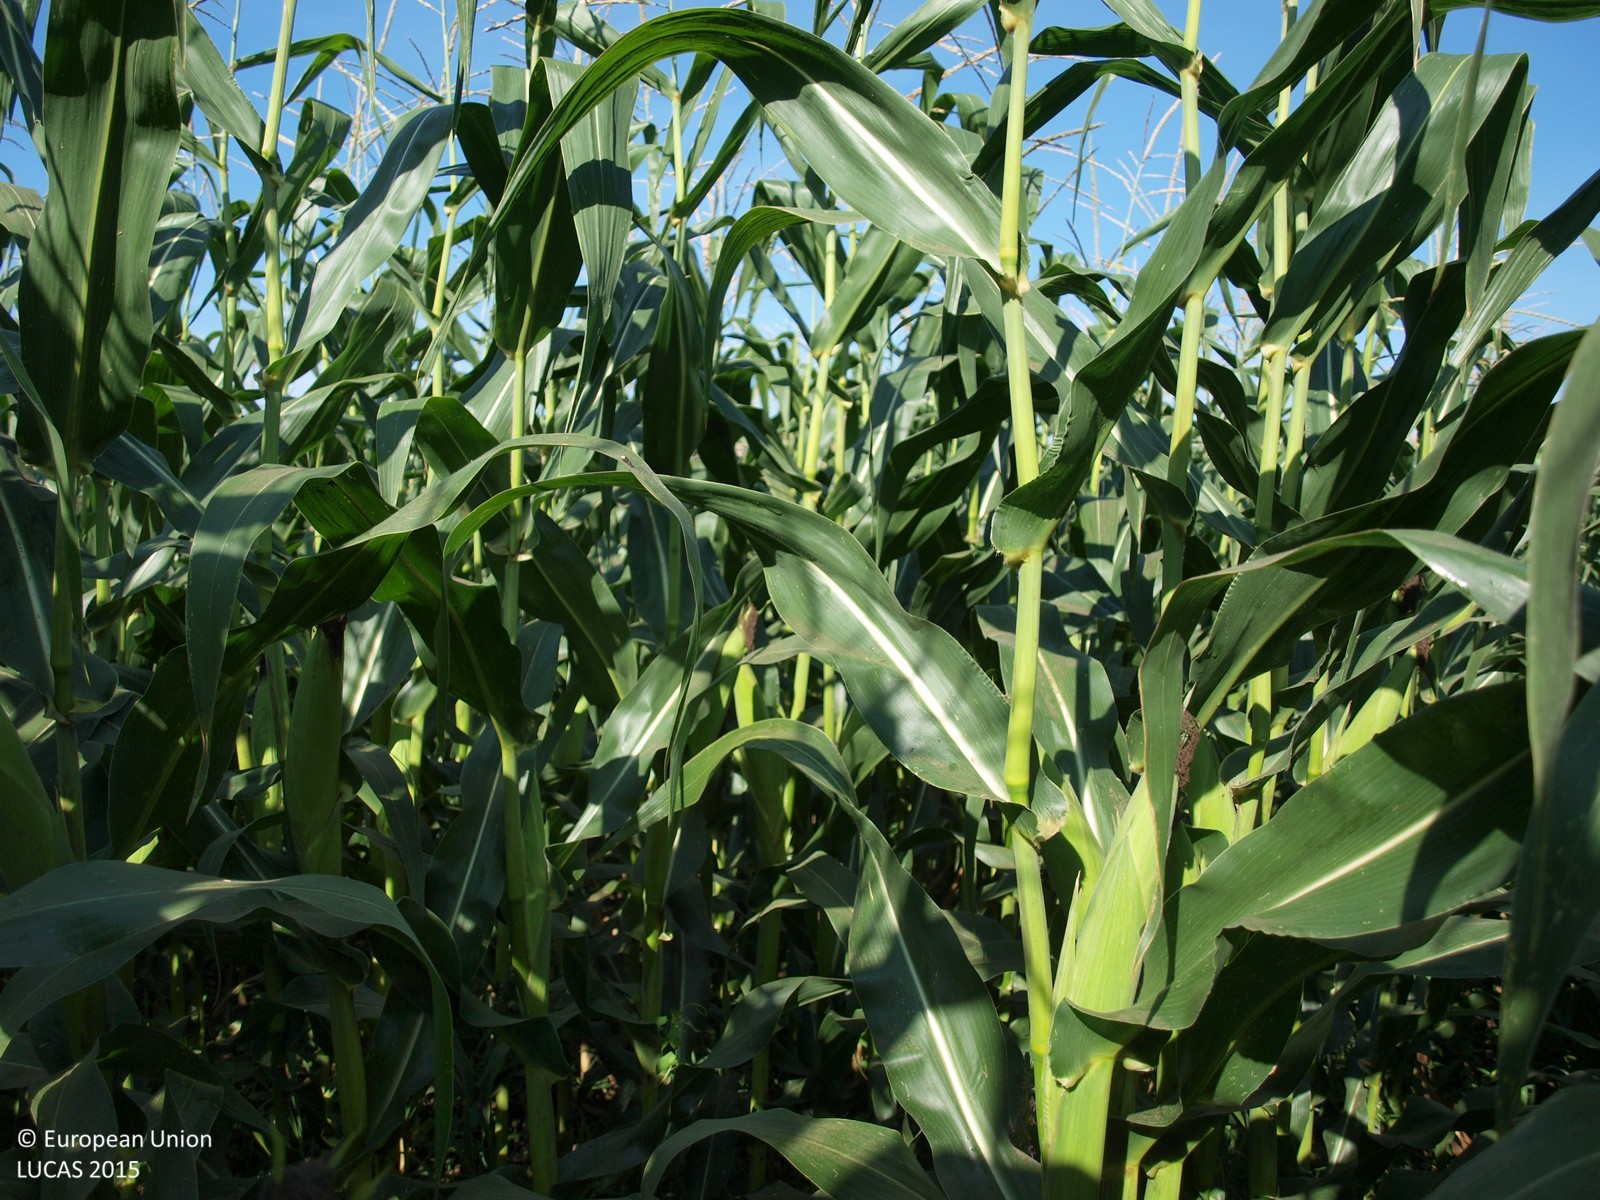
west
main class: Cropland
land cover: Maize
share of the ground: > 75 %
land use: Agriculture (excluding fallow land and kitchen gardens)
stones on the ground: < 10 %
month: August
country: HR
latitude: 46.0036
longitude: 16.2879
